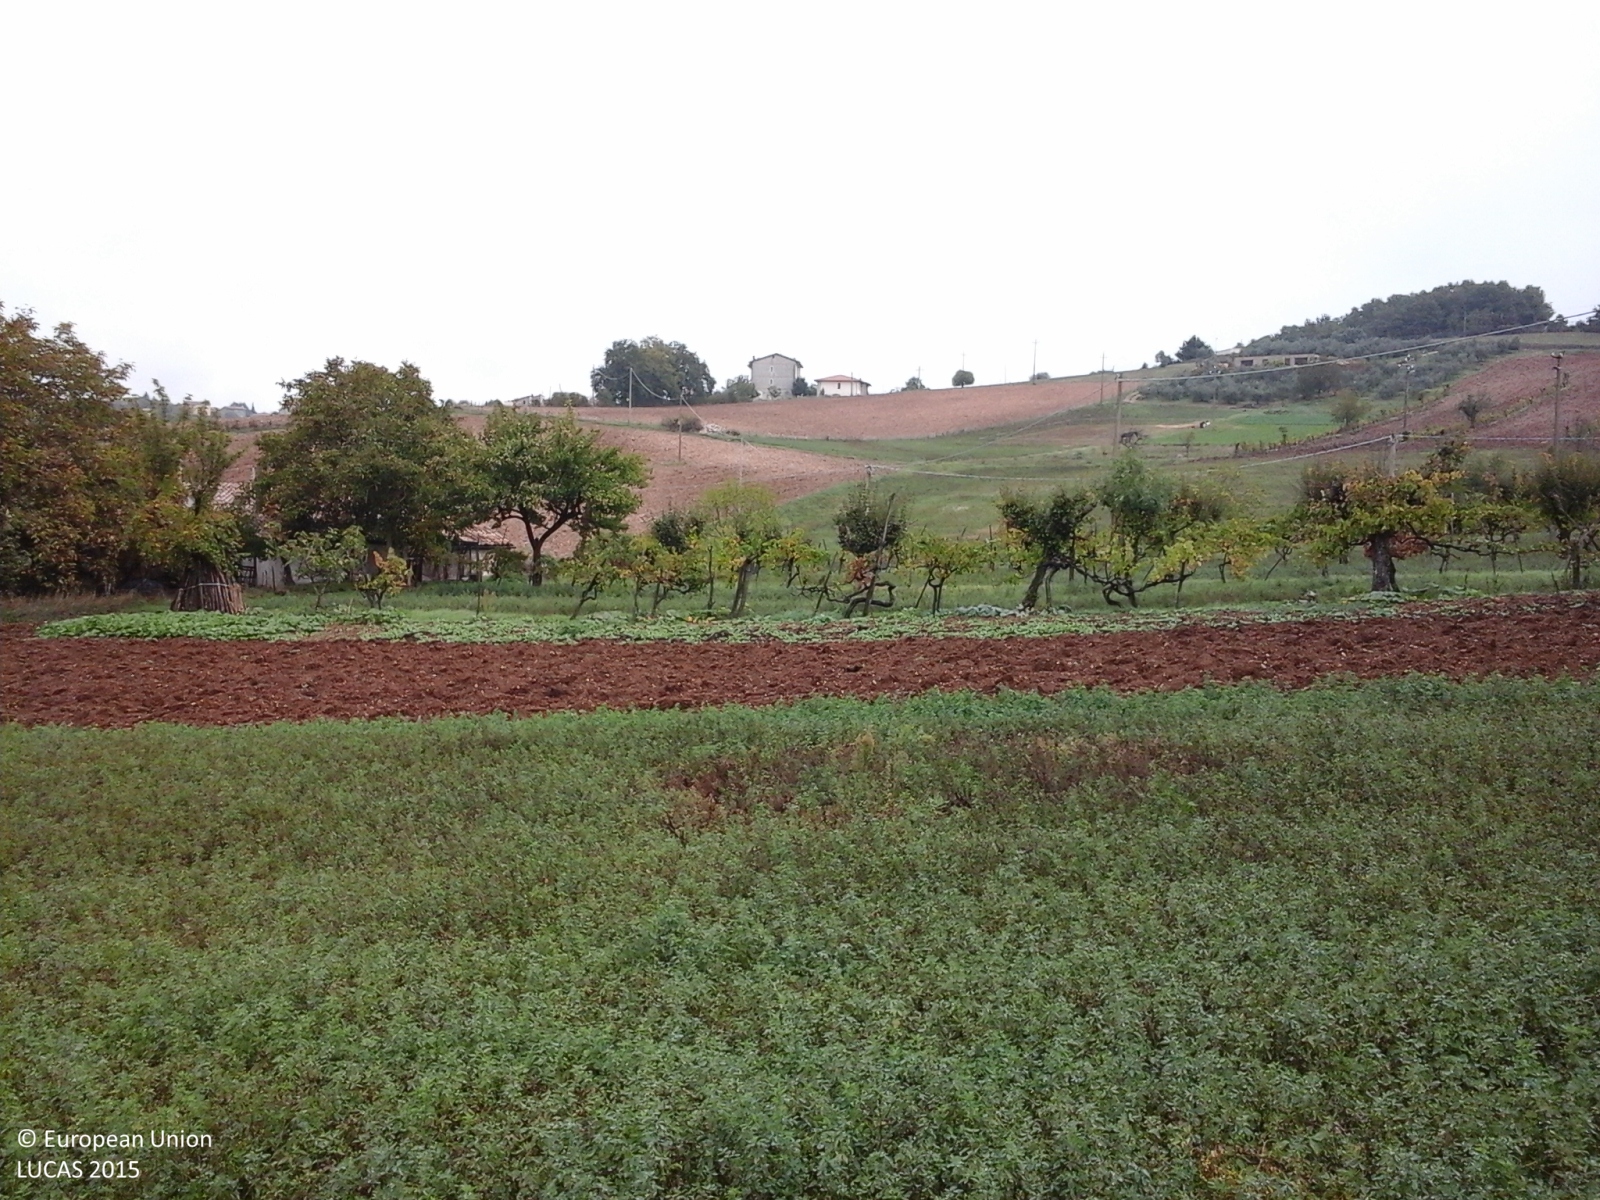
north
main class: Cropland
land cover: Clovers
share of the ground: > 75 %
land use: Agriculture (excluding fallow land and kitchen gardens)
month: October
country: IT
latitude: 42.6991
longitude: 12.3485
